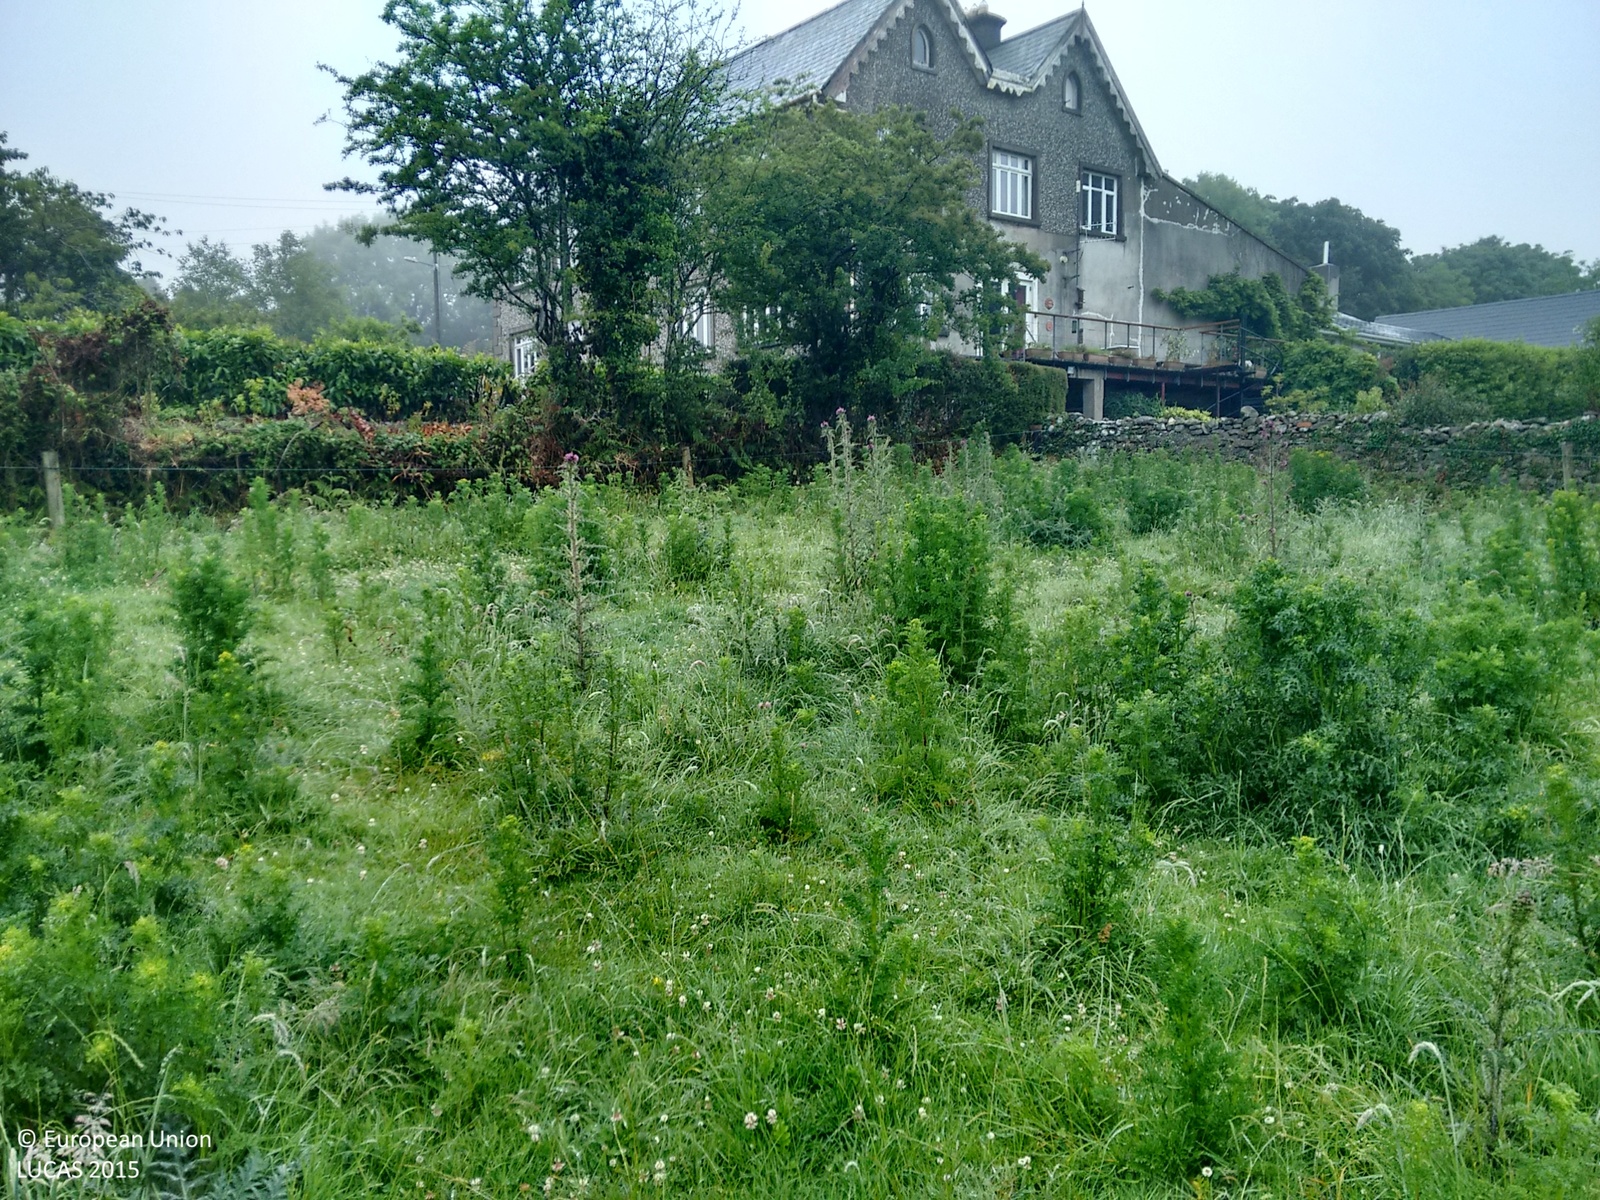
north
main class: Grassland
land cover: Grassland without tree/shrub cover
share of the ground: > 75 %
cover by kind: herbaceous plants 100 %
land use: Agriculture (excluding fallow land and kitchen gardens)
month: June
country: IE
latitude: 52.3823
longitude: -7.2974
